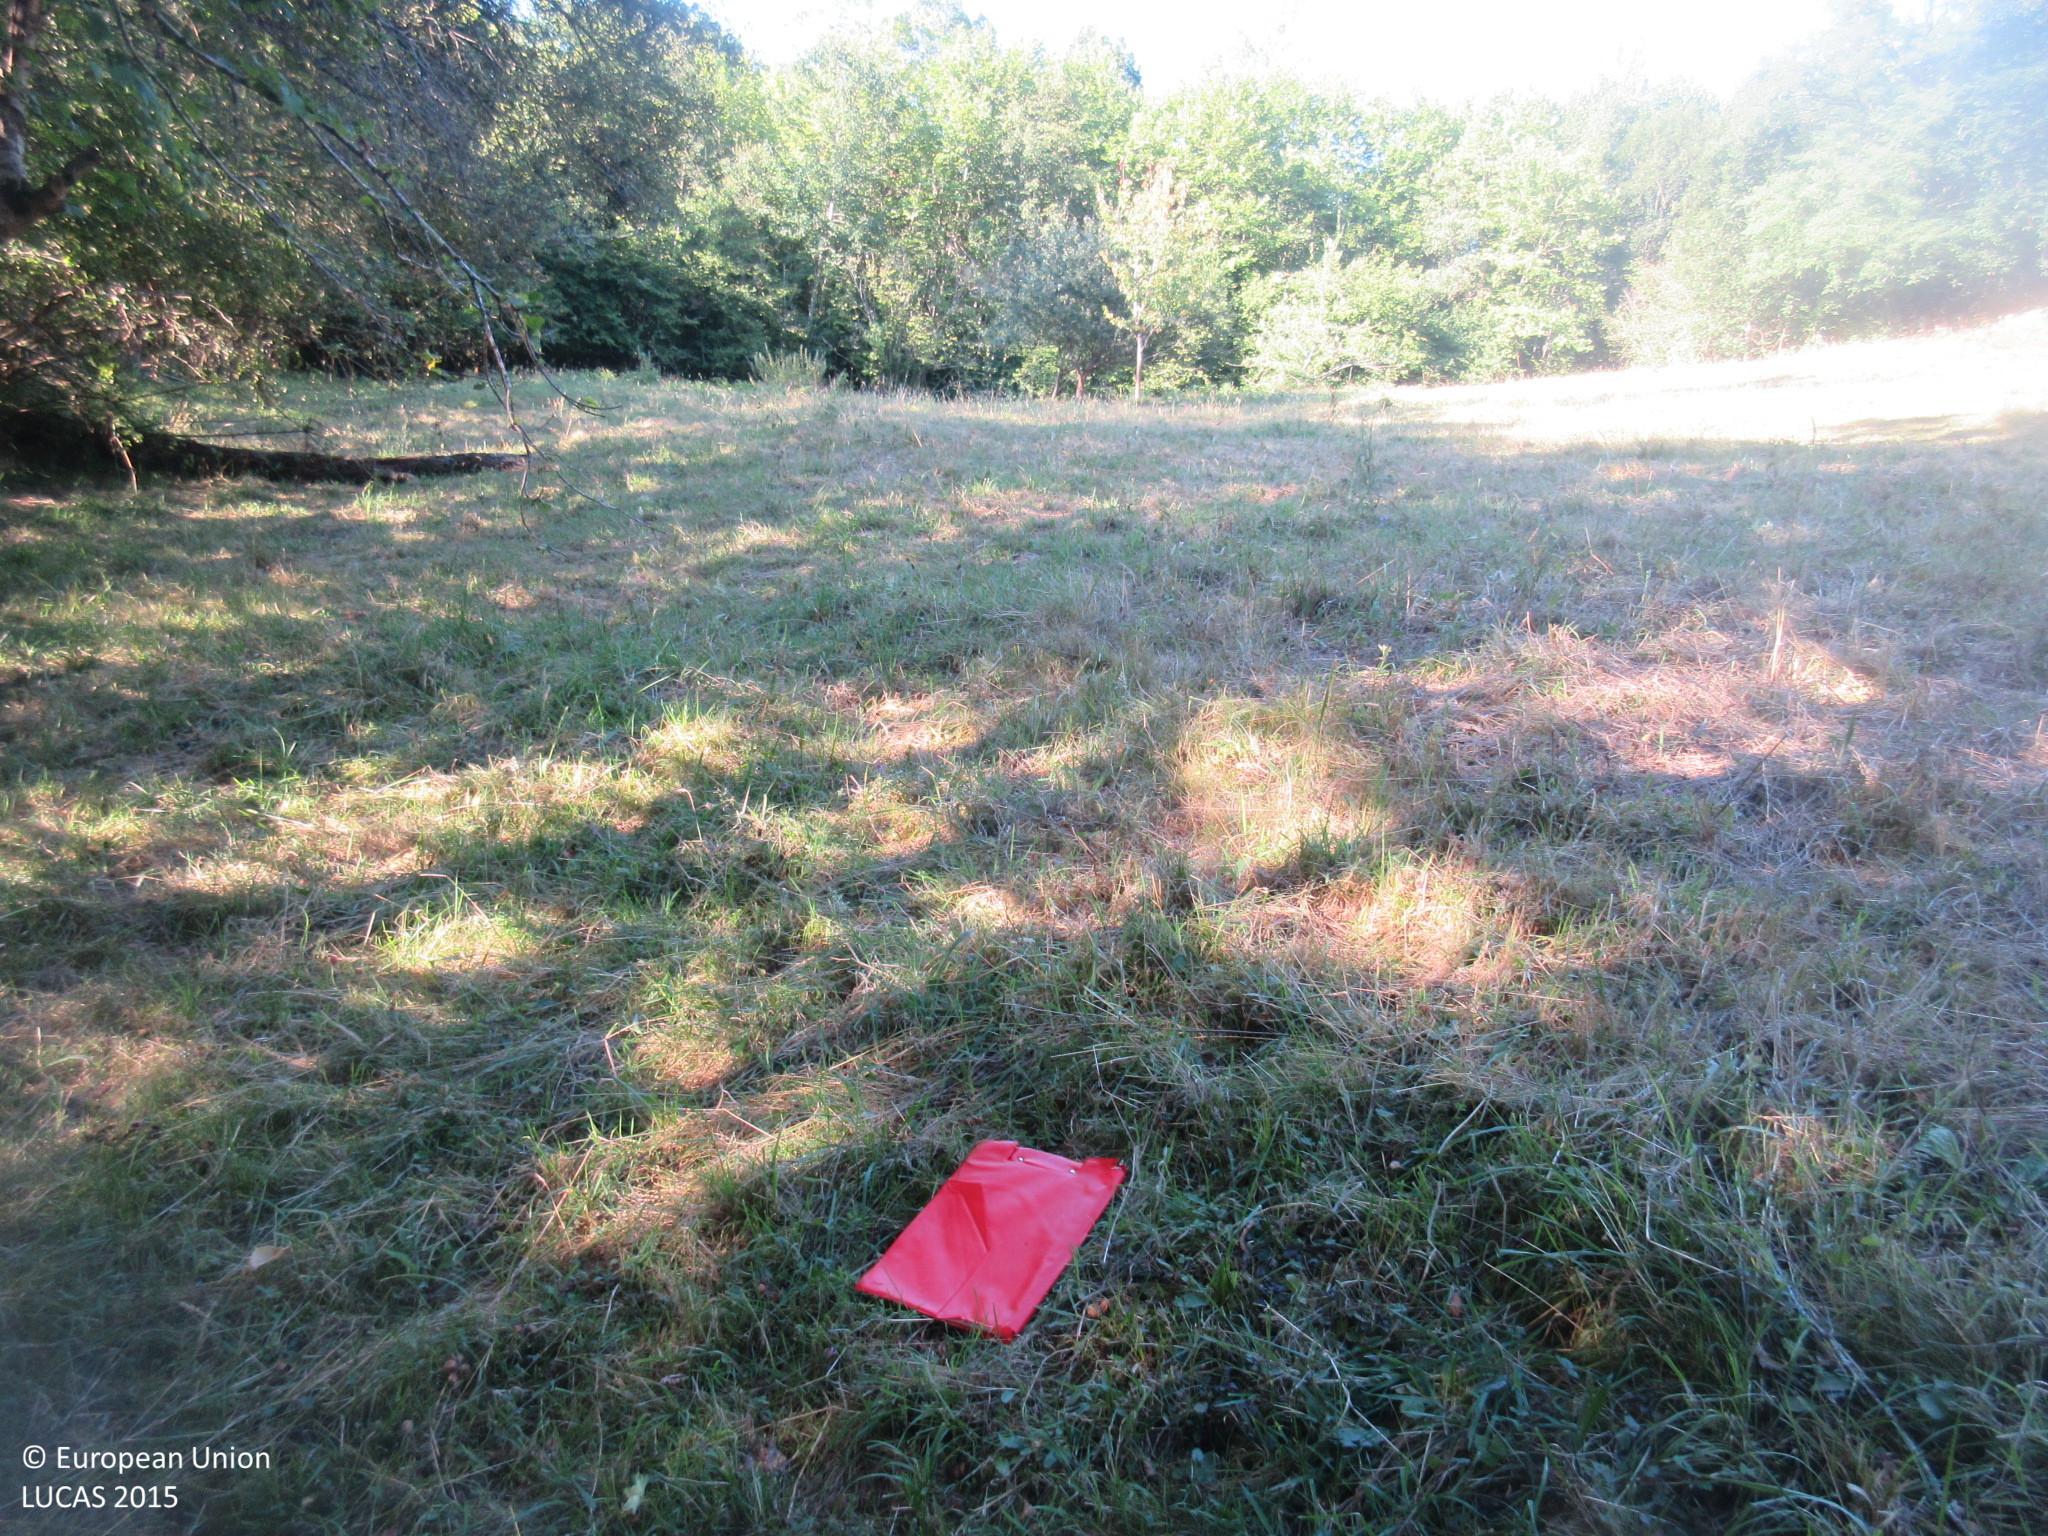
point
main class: Grassland
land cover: Grassland without tree/shrub cover
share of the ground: > 75 %
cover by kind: herbaceous plants 100 %
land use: Agriculture (excluding fallow land and kitchen gardens)
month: July
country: ES
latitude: 43.3537
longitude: -5.0612
